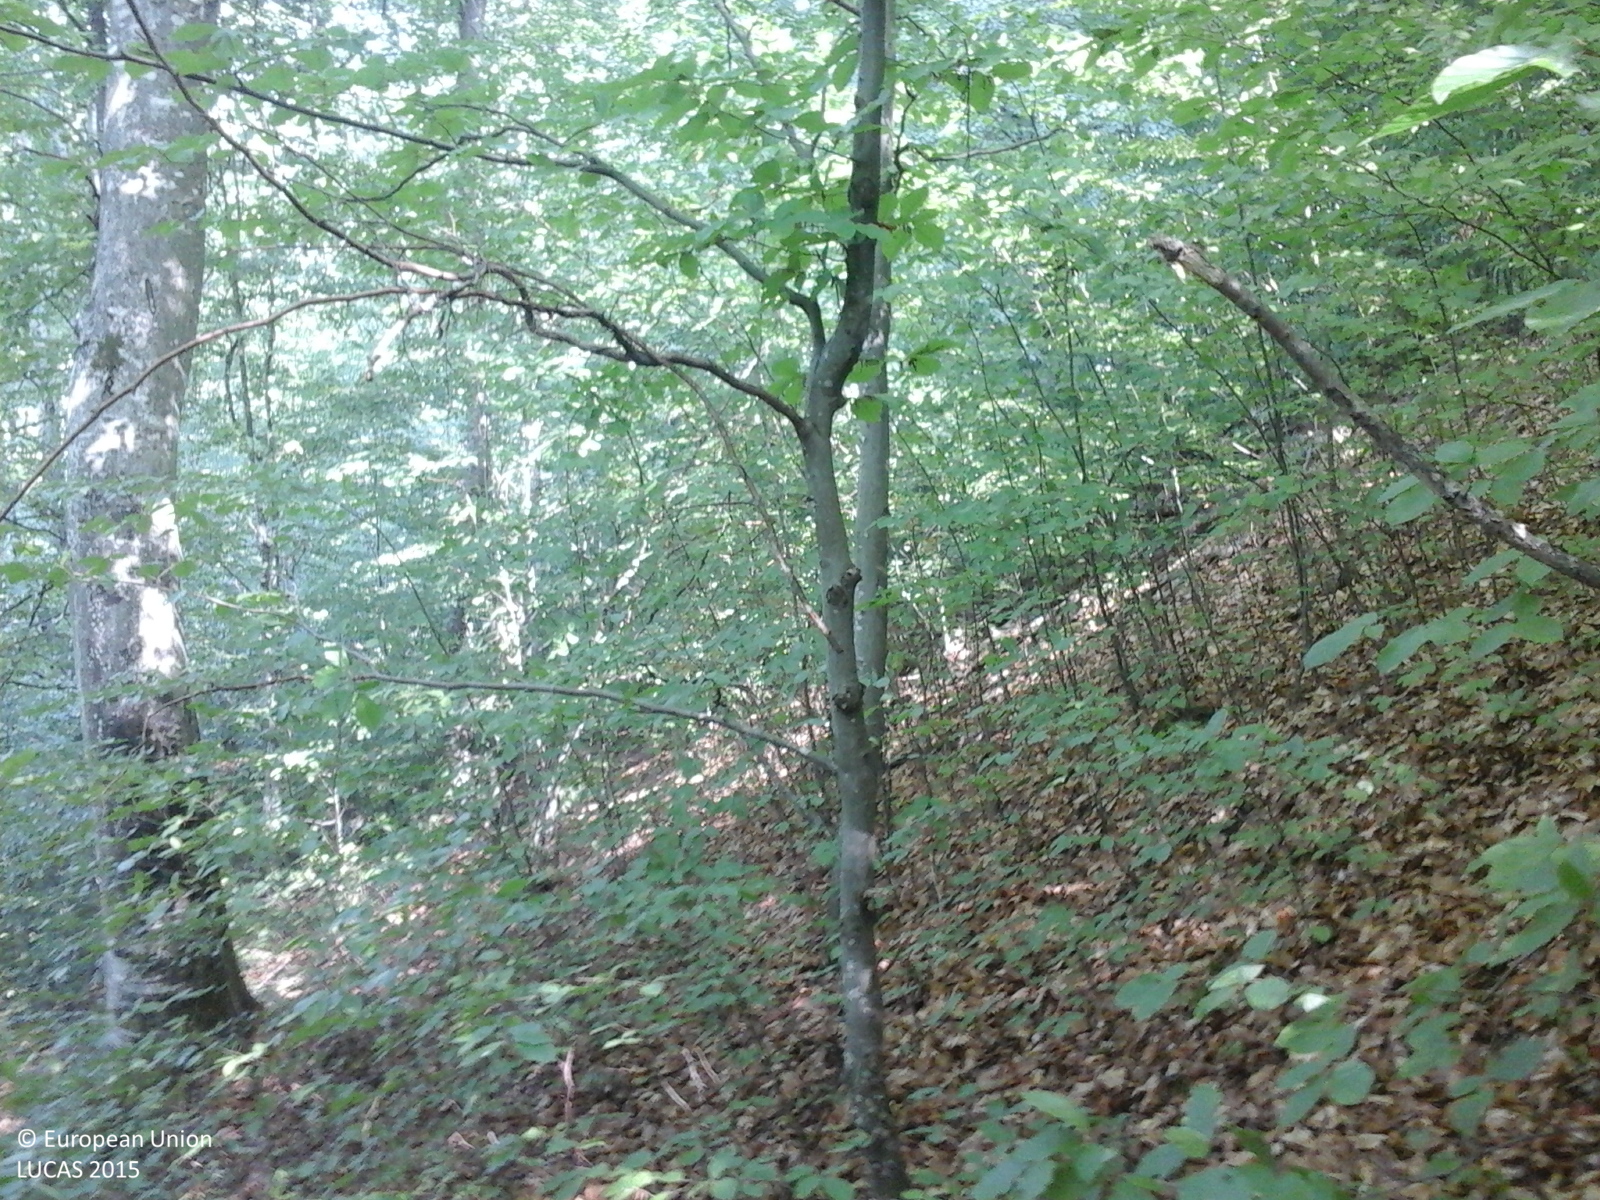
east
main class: Woodland
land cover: Broadleaved woodland
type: beech forest
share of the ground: > 75 %
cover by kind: broadleaved forest trees 100 %
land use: Forestry
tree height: > 5 m
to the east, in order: Broadleaved woodland
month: September
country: RO
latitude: 47.8201
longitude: 24.2615
